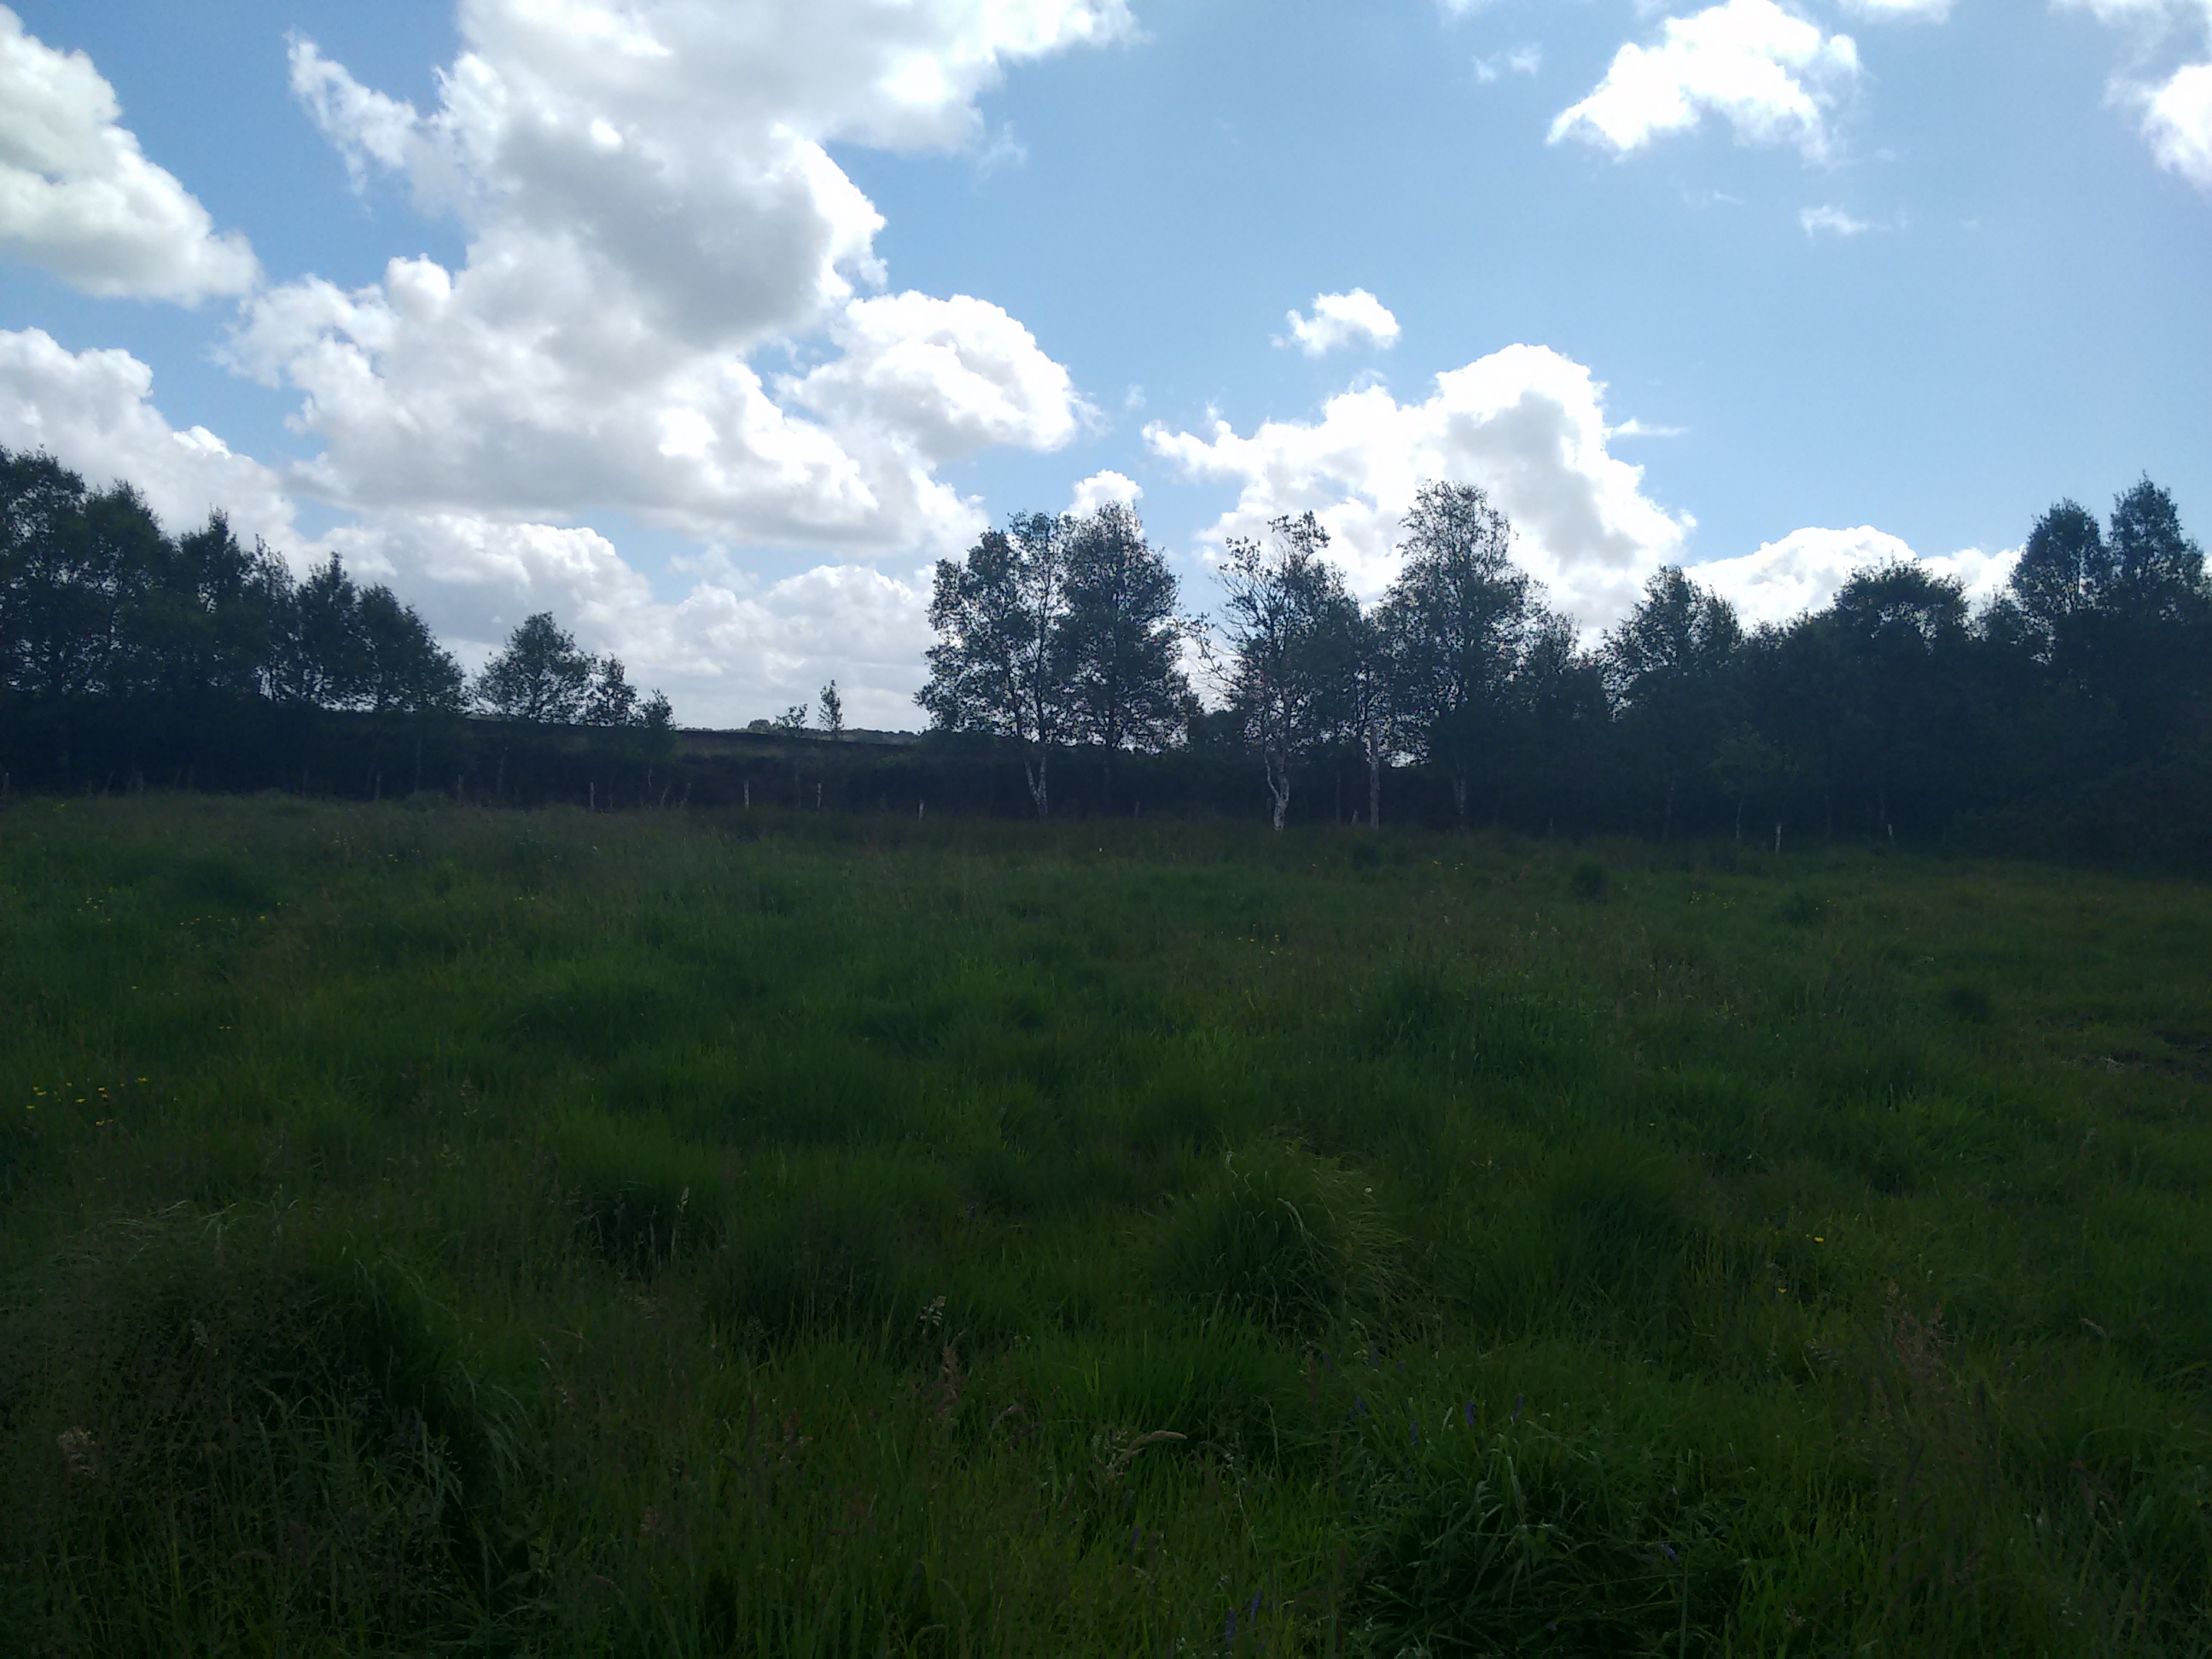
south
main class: Grassland
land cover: Grassland without tree/shrub cover
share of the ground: > 75 %
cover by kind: herbaceous plants 95 %, consolidated bare surface 5 %
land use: Agriculture (excluding fallow land and kitchen gardens)
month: June
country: IE
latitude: 53.3417
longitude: -7.9102
